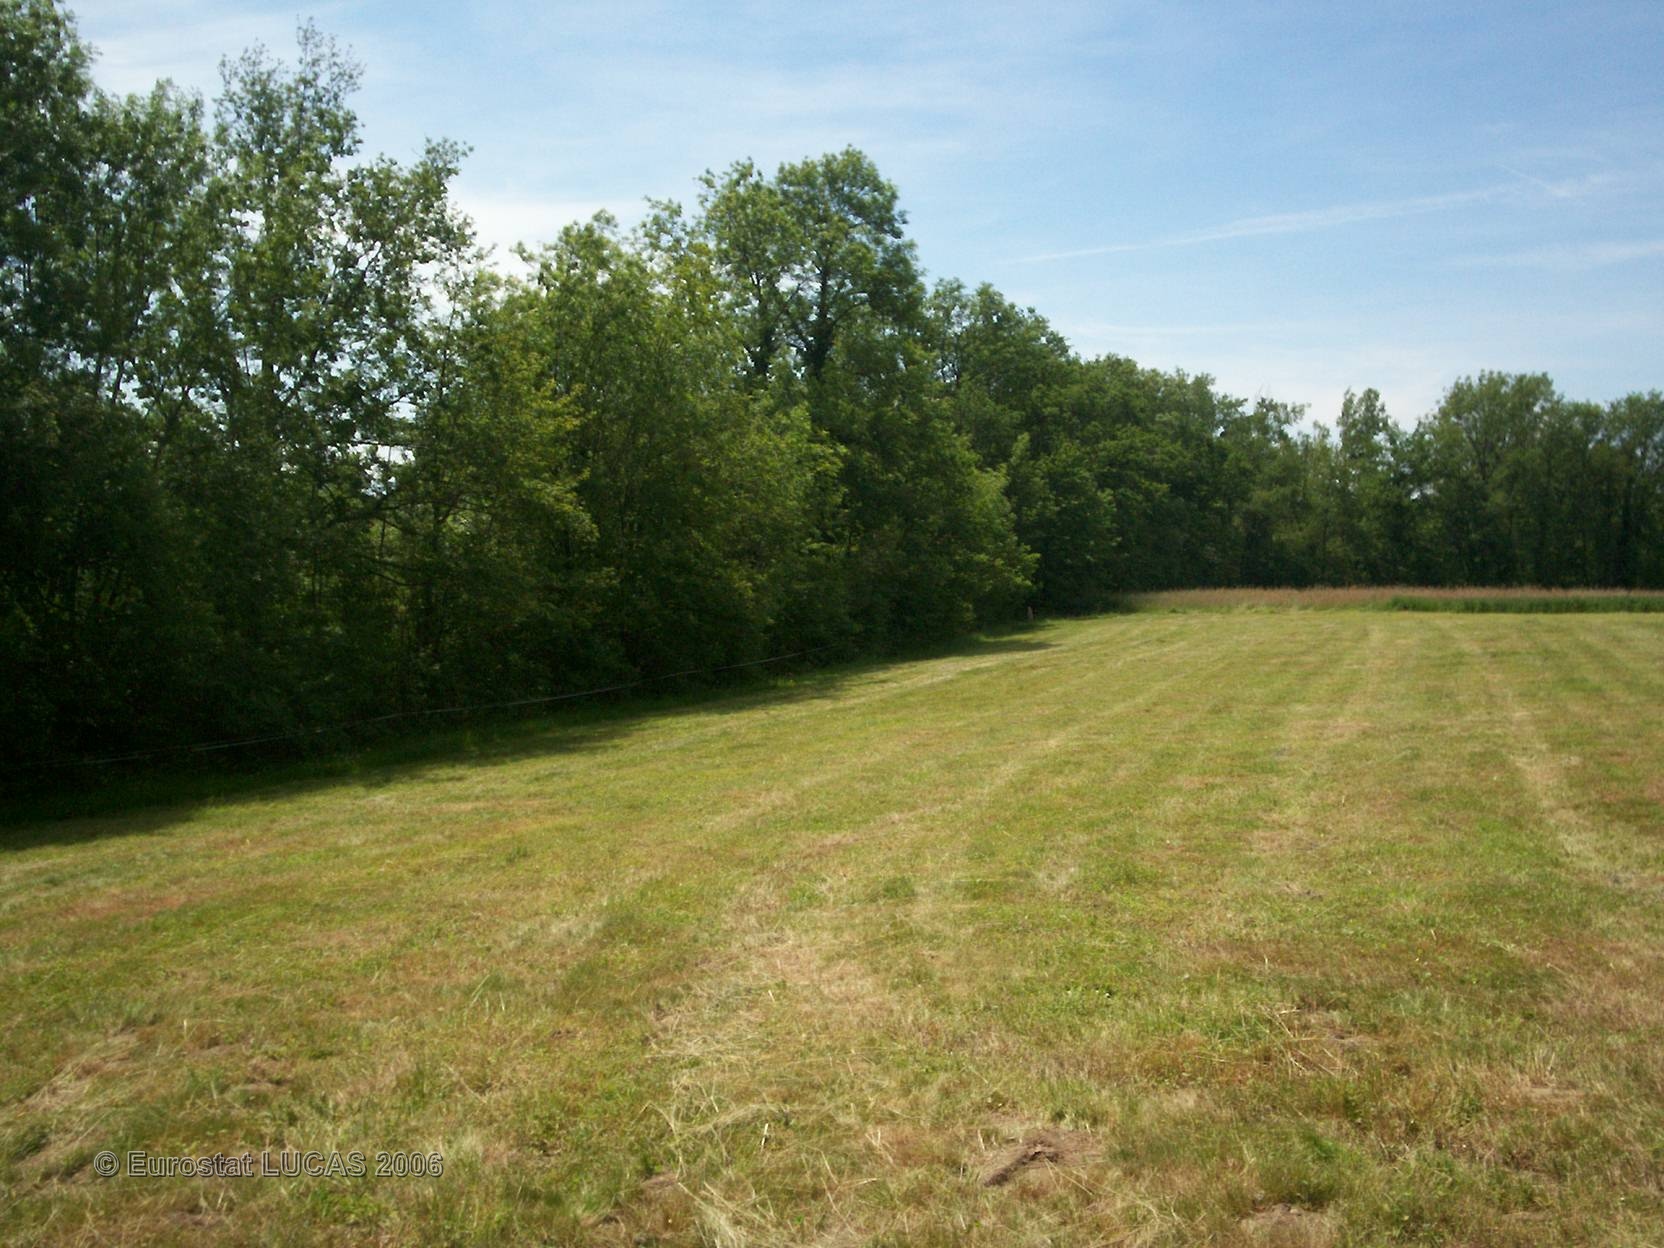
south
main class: Grassland
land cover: Grassland without tree/shrub cover
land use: Agriculture (excluding fallow land and kitchen gardens)
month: June
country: FR
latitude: 46.3160
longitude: 6.0943
